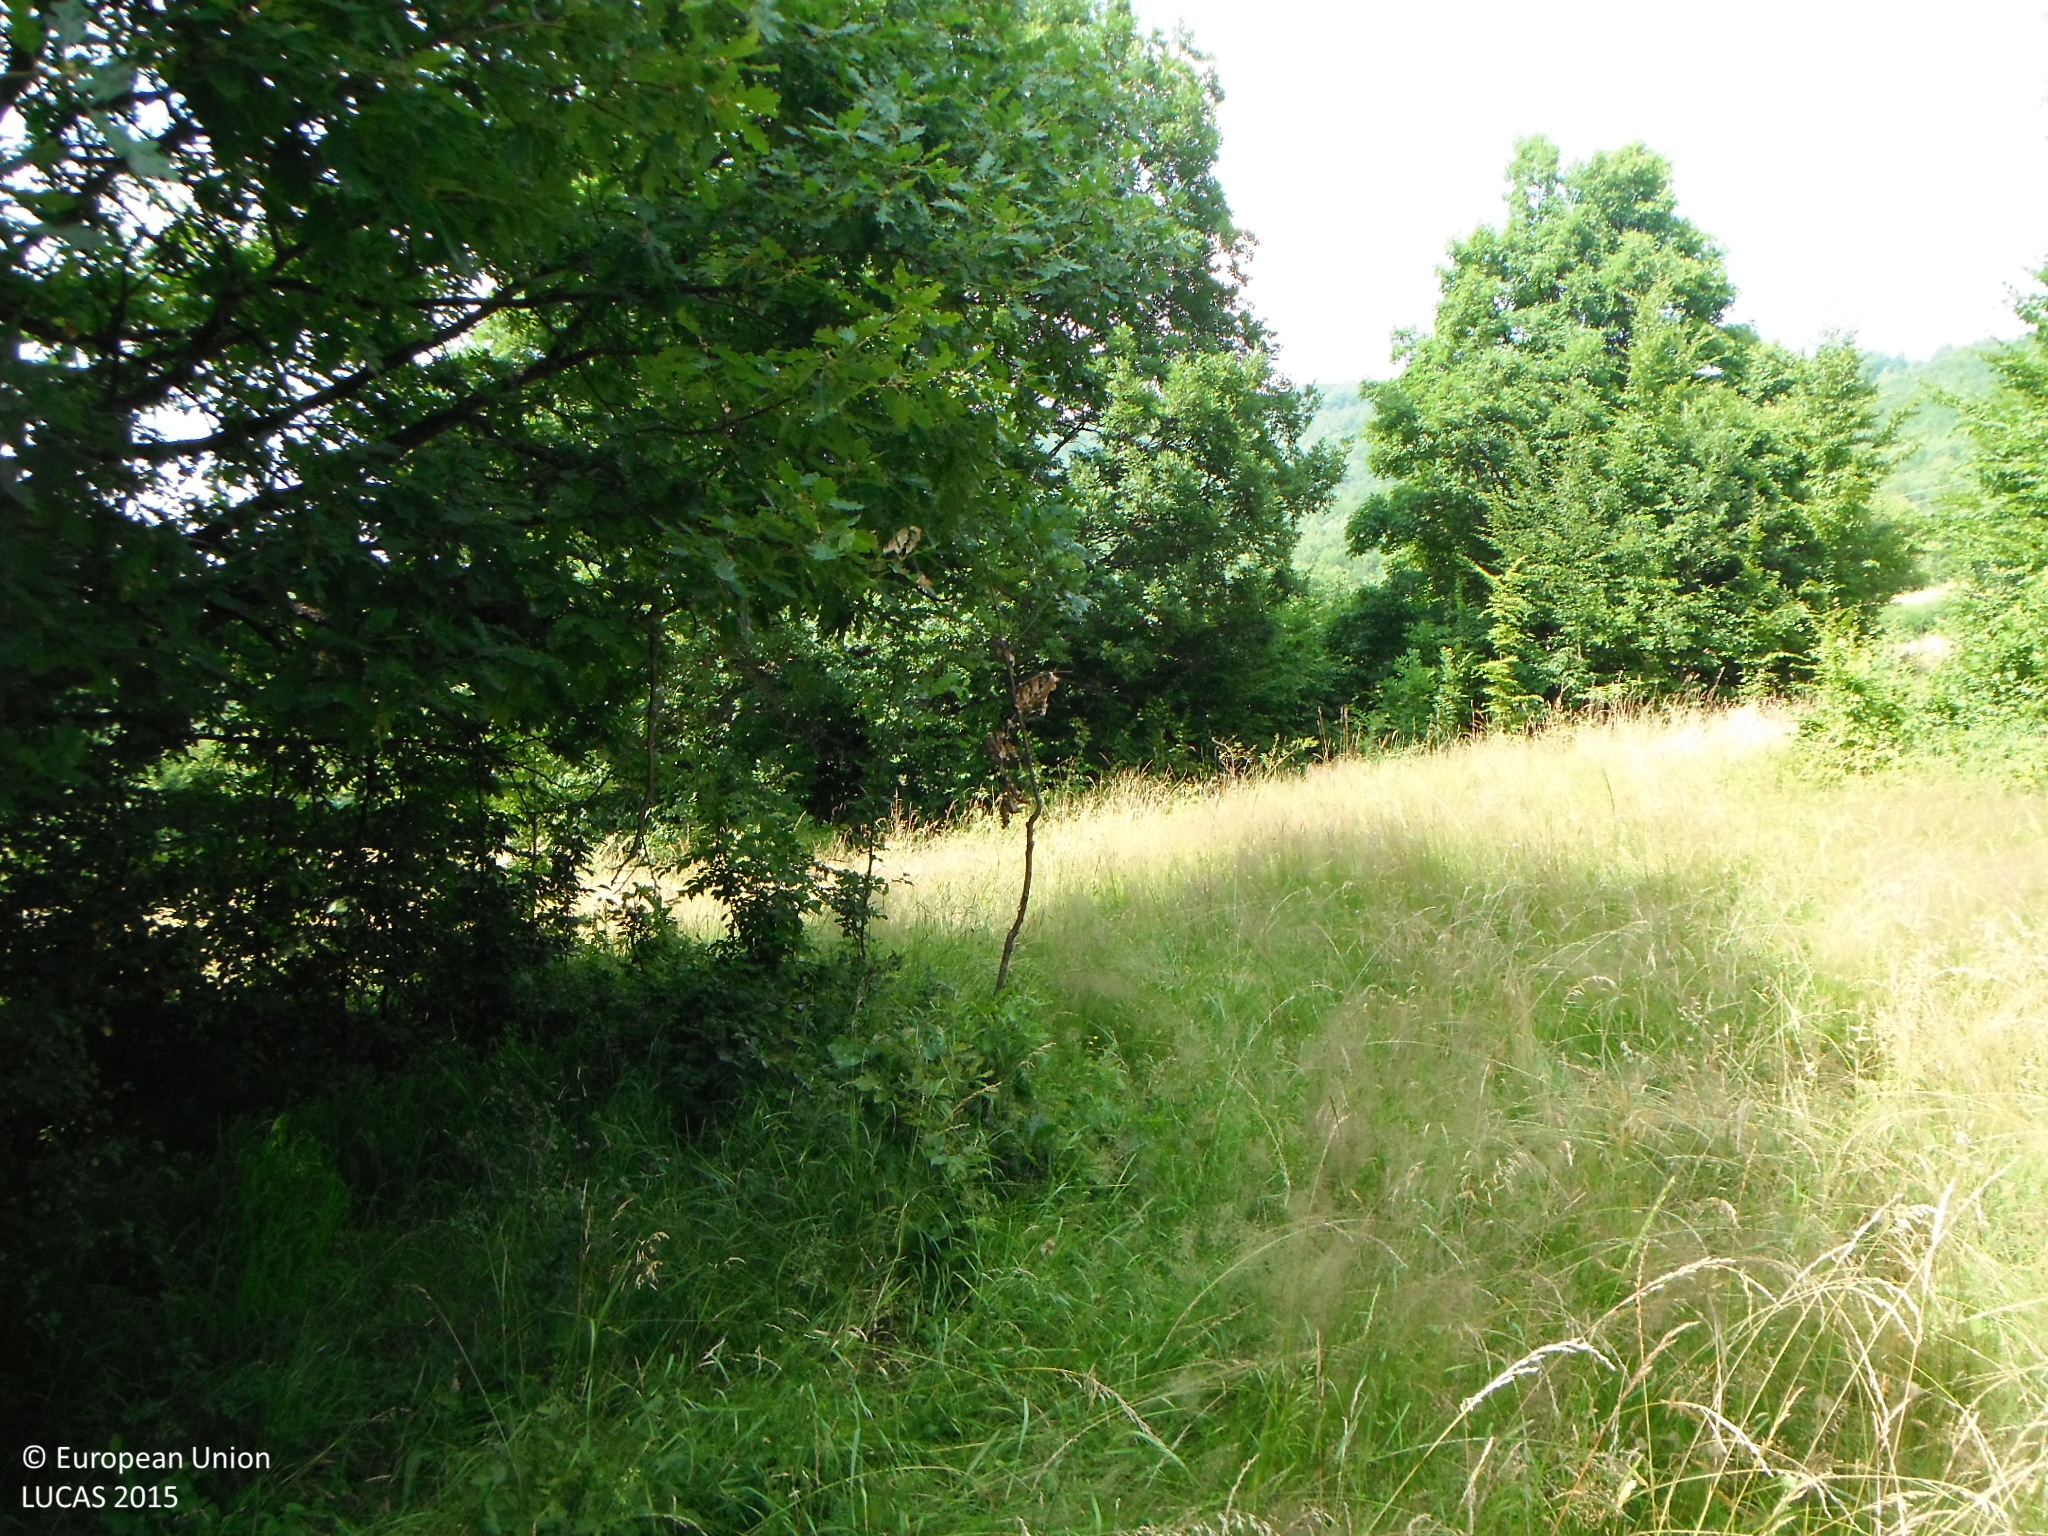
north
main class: Grassland
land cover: Grassland with sparse tree/shrub cover
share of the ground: > 75 %
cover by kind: herbaceous plants 85 %, shrubs 10 %, broadleaved forest trees 5 %
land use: Agriculture (excluding fallow land and kitchen gardens)
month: July
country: SK
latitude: 48.5071
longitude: 19.2130
